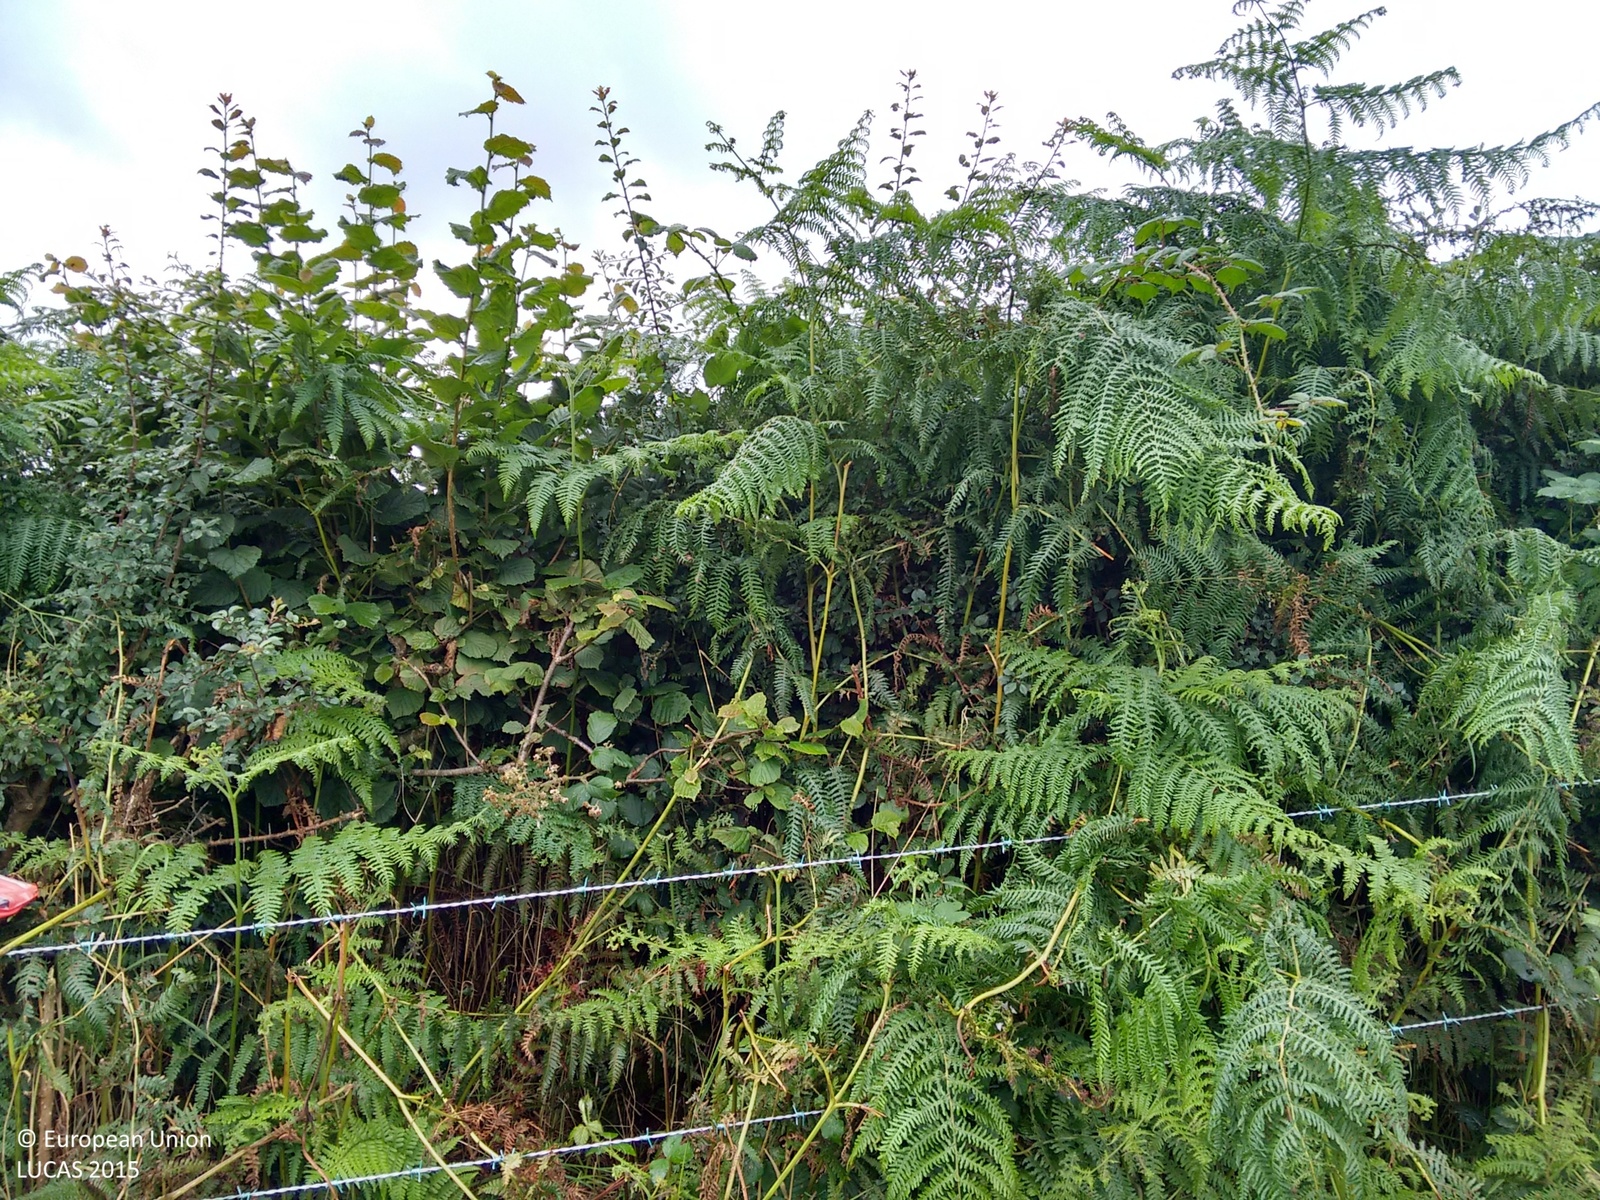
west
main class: Grassland
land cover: Grassland without tree/shrub cover
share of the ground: > 75 %
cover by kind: herbaceous plants 100 %
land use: Agriculture (excluding fallow land and kitchen gardens)
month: August
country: GB
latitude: 51.8569
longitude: -4.8508
